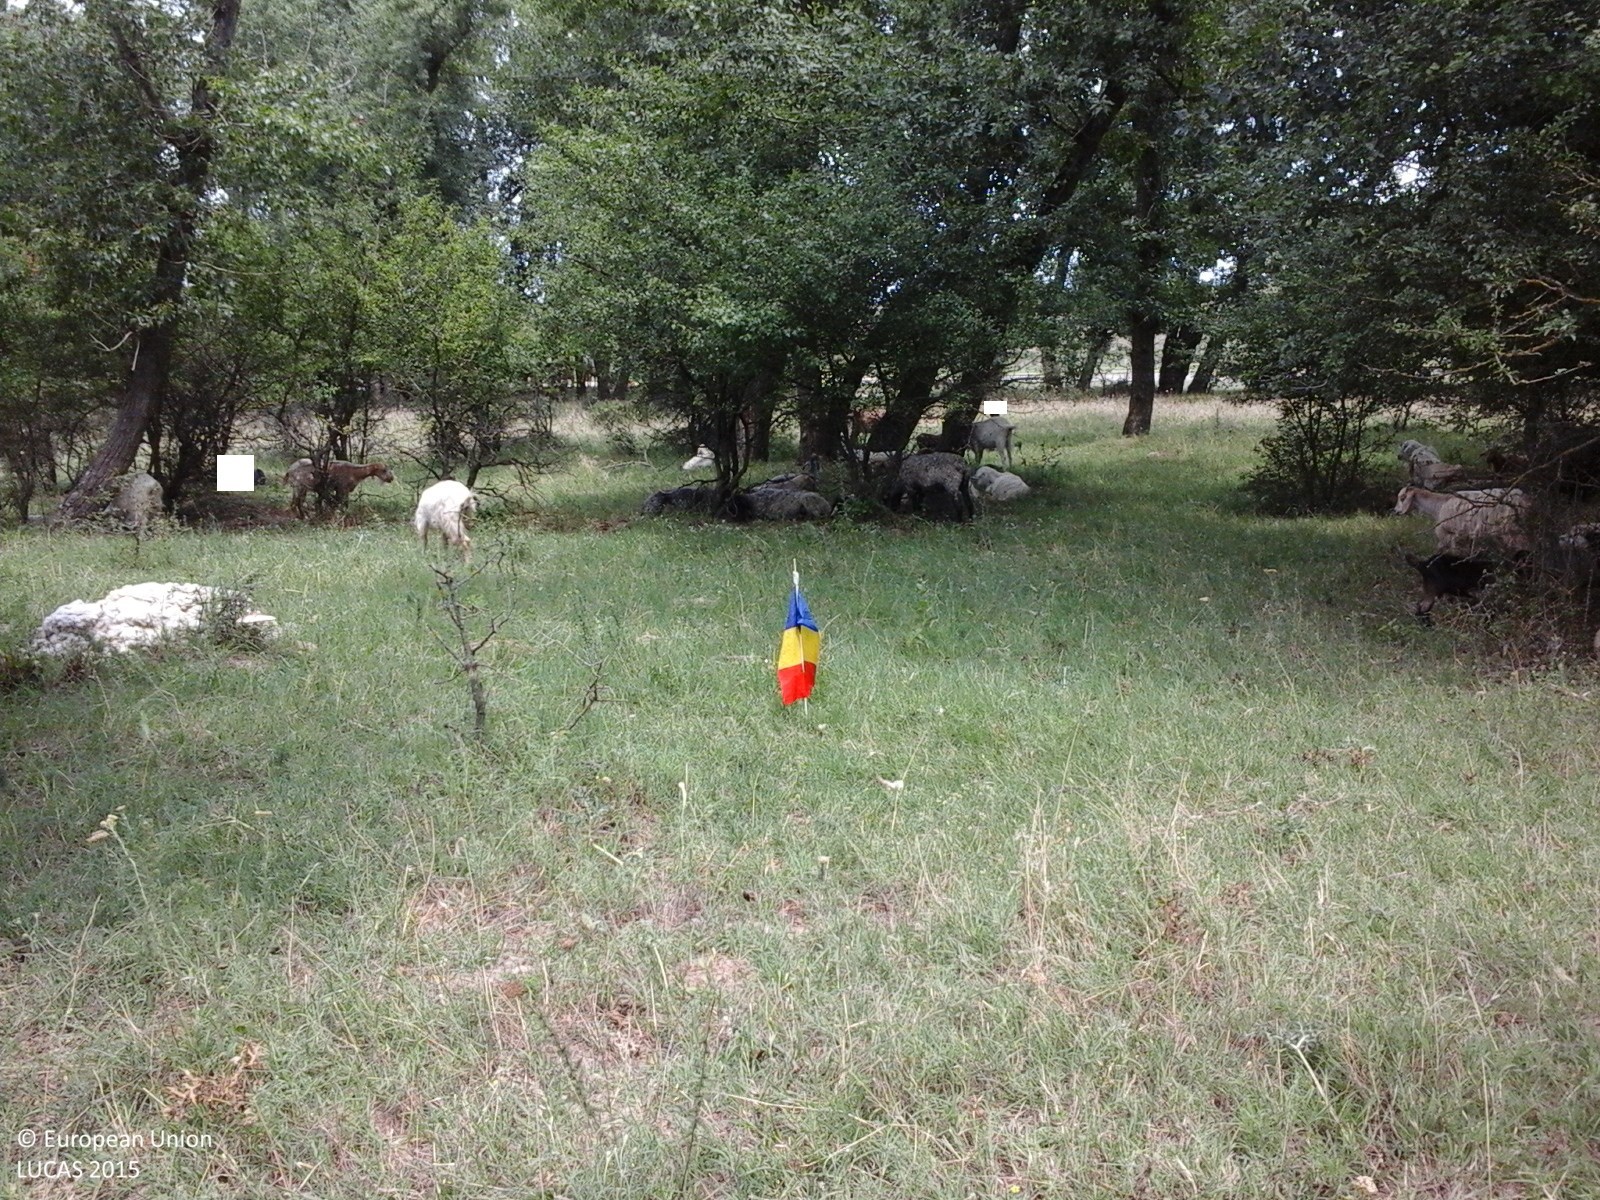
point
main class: Woodland
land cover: Broadleaved woodland
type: non-riverine alder, birch or aspen forest
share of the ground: 50 - 75 %
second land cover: Grassland without tree/shrub cover
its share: > 75 %
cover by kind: broadleaved forest trees 60 %, herbaceous plants 40 %
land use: Forestry
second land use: Agriculture (excluding fallow land and kitchen gardens)
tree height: > 5 m
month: July
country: RO
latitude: 43.9719
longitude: 24.5896
